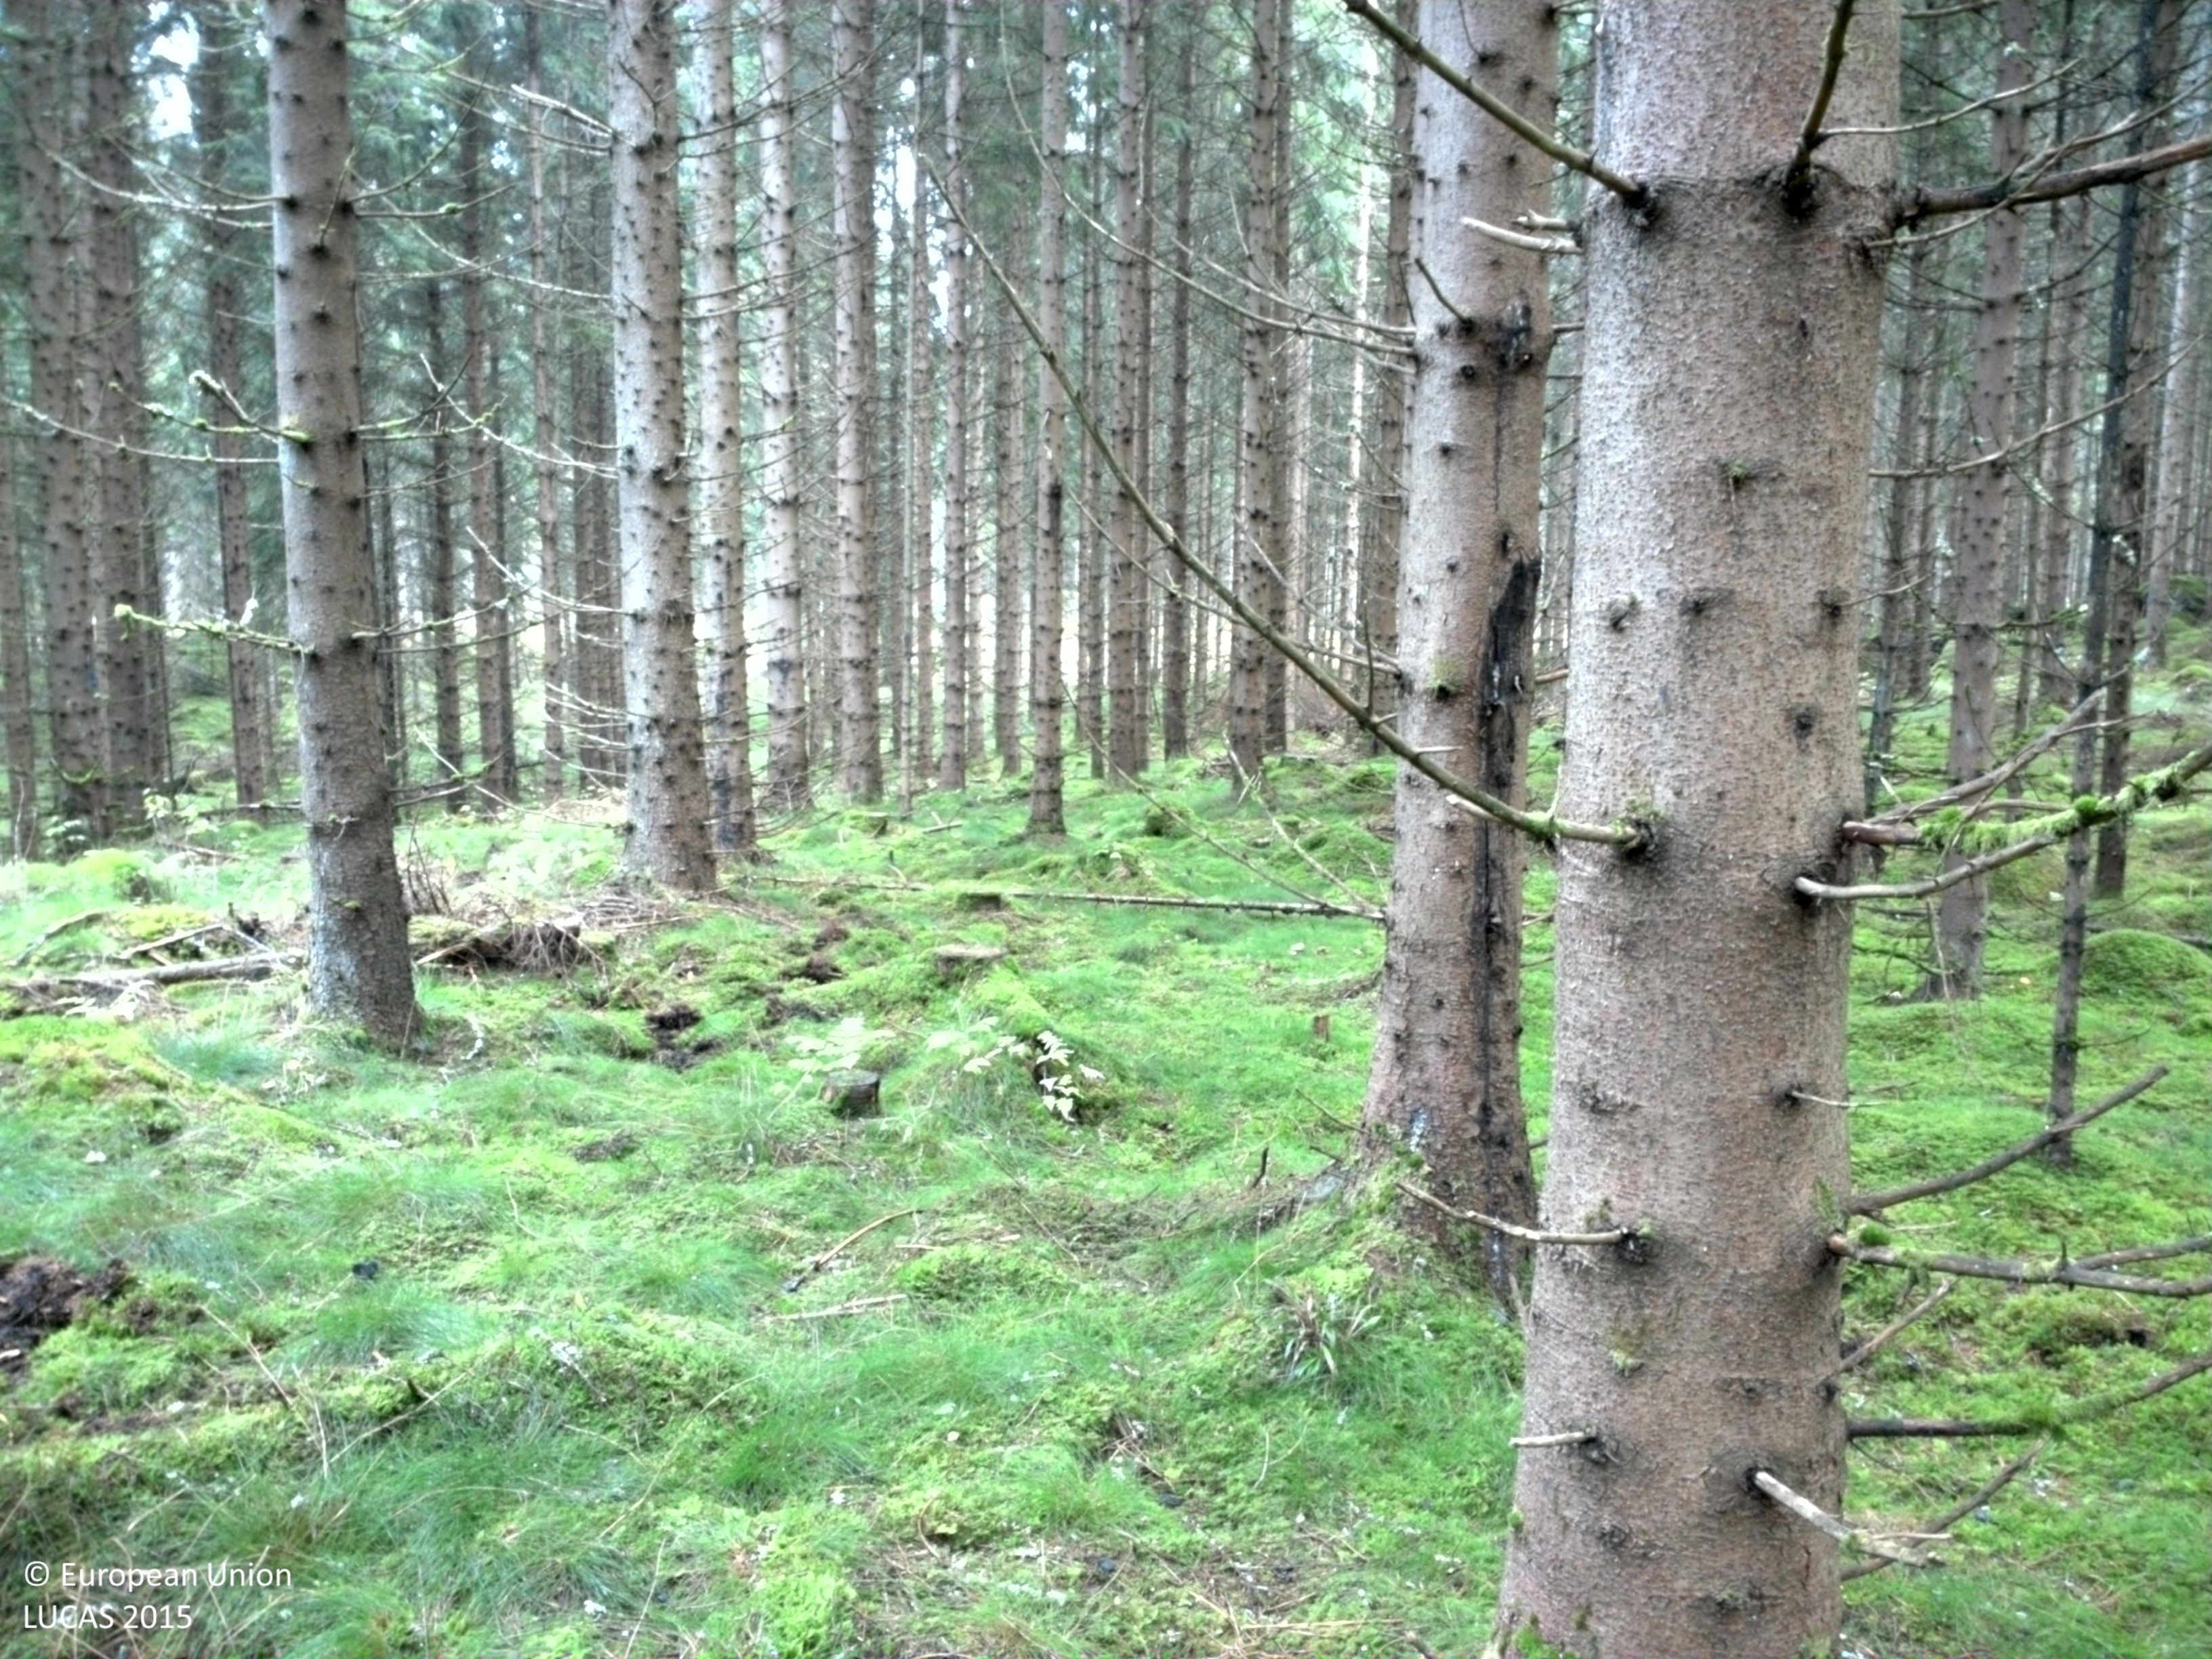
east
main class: Woodland
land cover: Spruce dominated coniferous woodland
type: boreal forest
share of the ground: 50 - 75 %
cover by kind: coniferous forest trees 60 %, lichens and mosses 30 %, herbaceous plants 10 %
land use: Forestry
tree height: > 5 m
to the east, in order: Spruce dominated coniferous woodland; Shruby margins; Paved roads, cycling and walking lanes; Shruby margins; Ditches and canals; Spruce dominated coniferous woodland
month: September
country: SE
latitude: 58.1289
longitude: 13.1362
